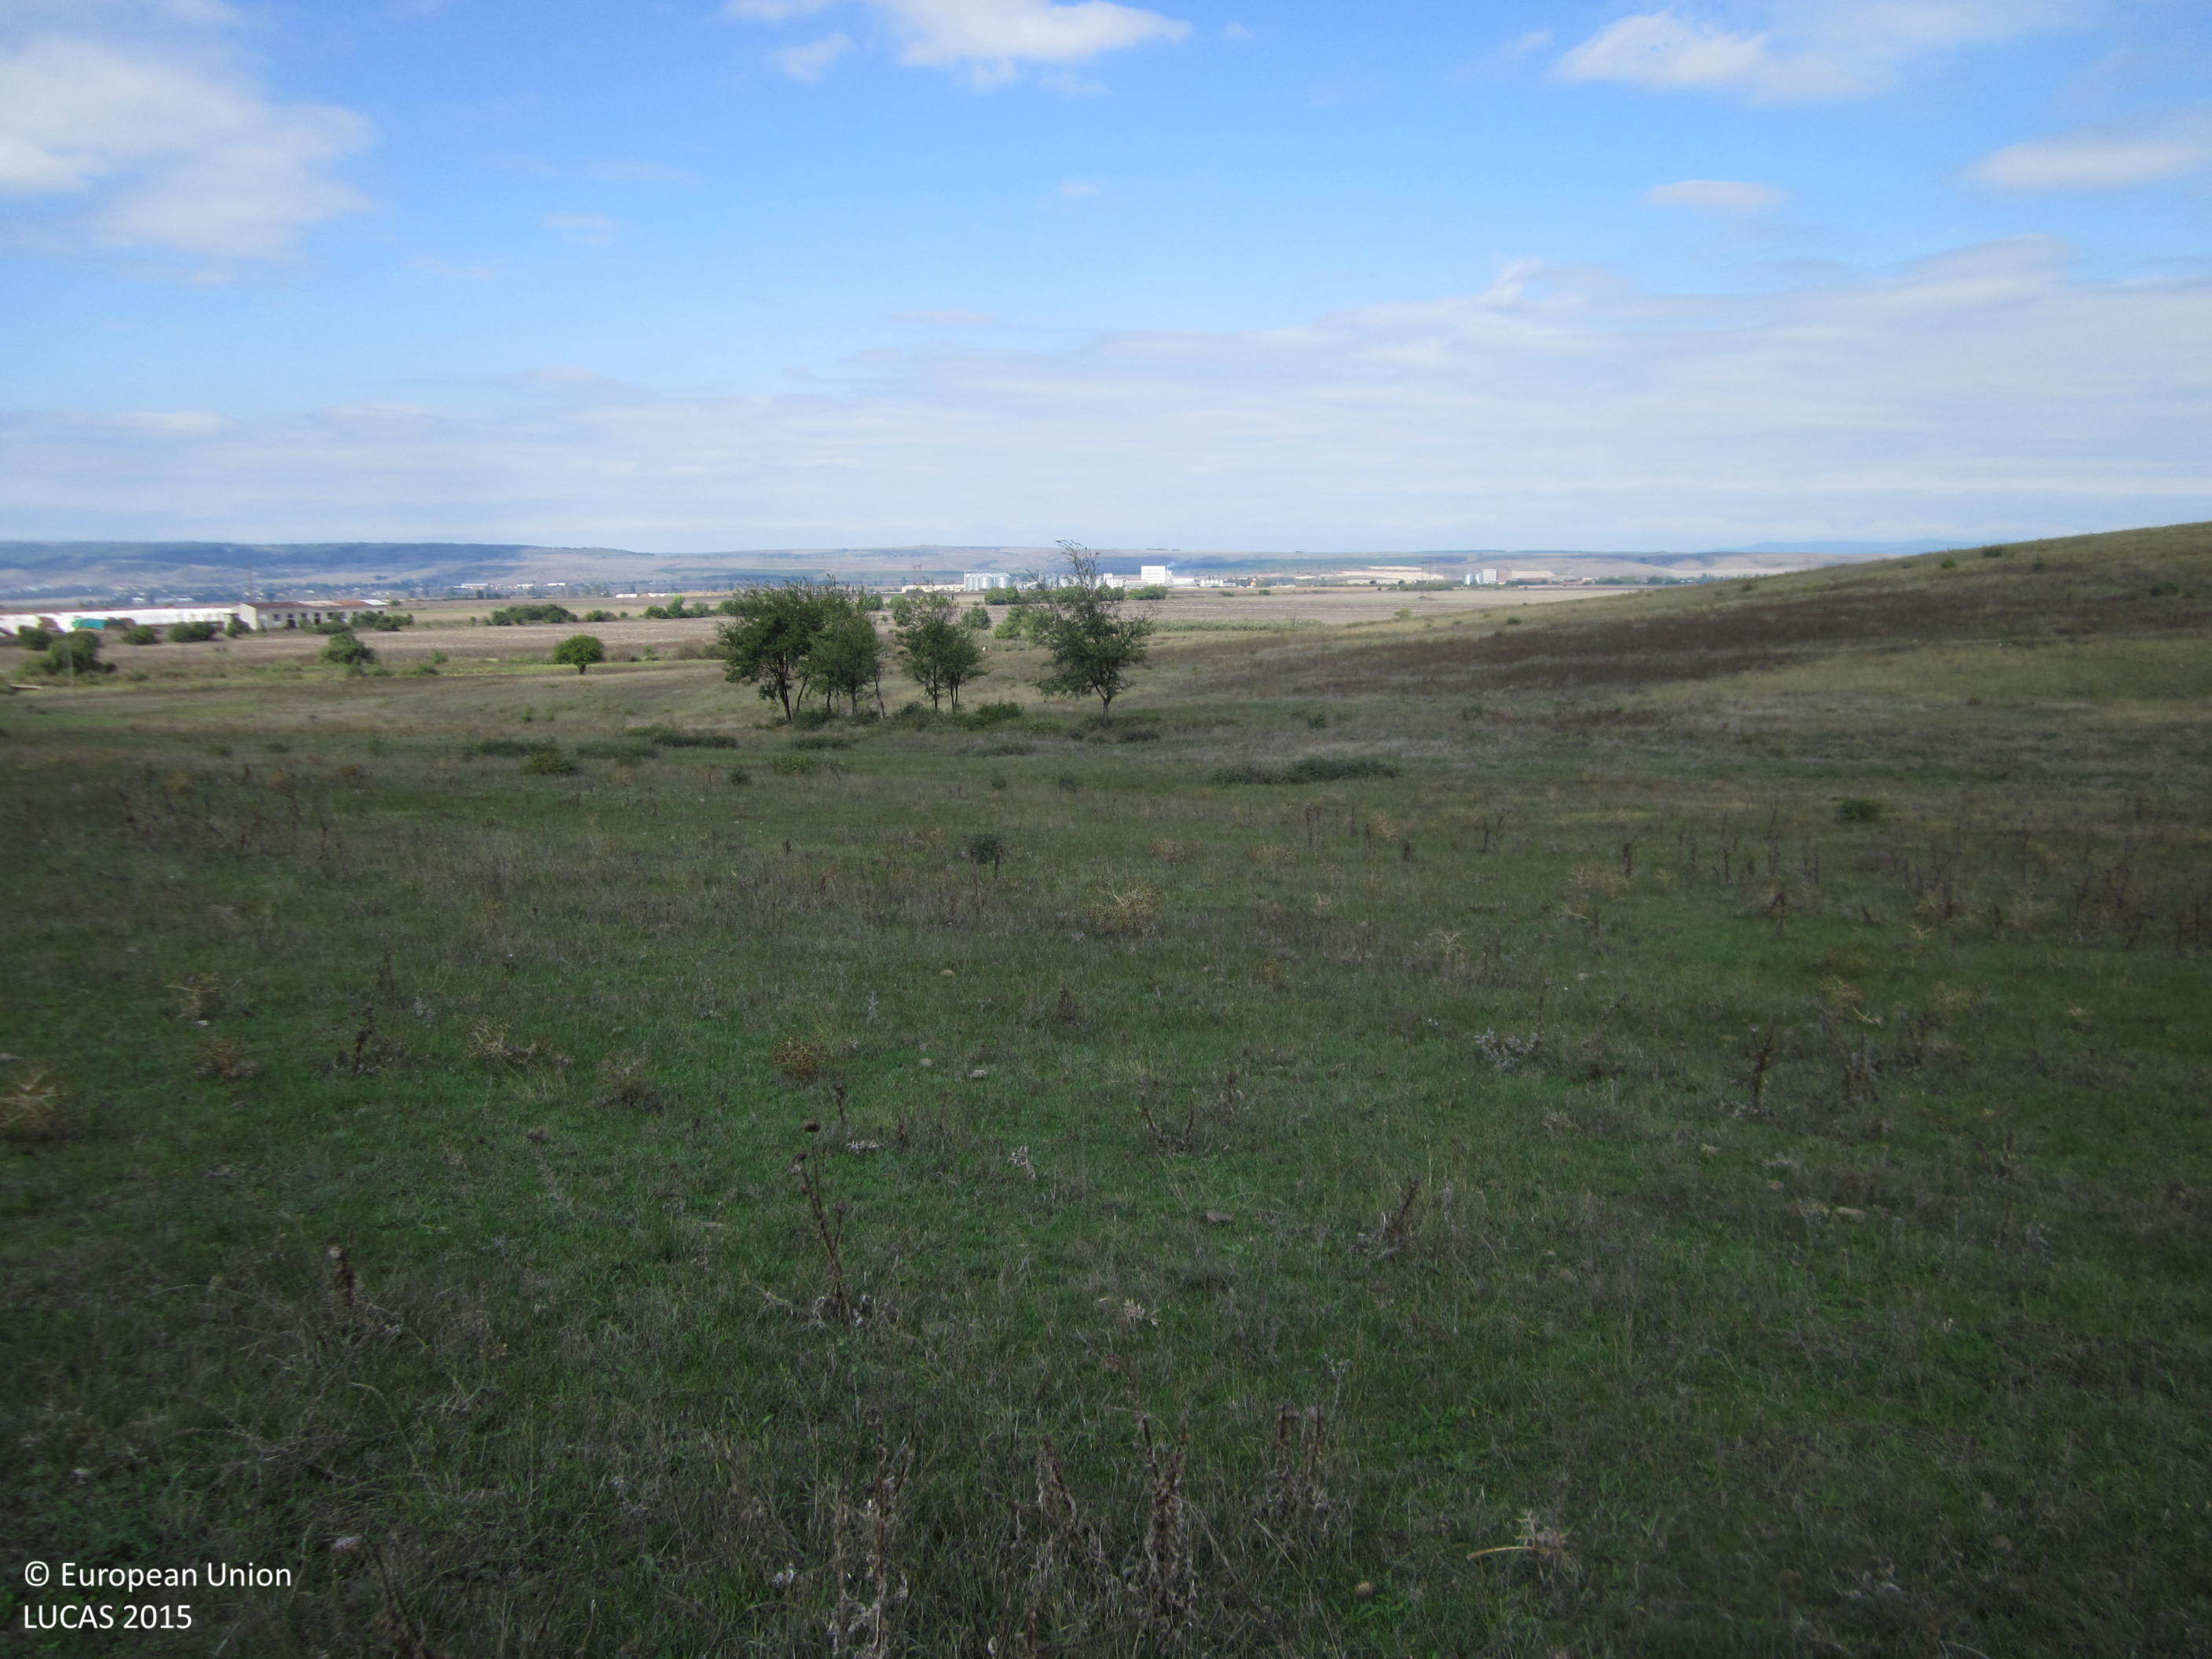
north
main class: Grassland
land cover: Grassland without tree/shrub cover
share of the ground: > 75 %
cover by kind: herbaceous plants 100 %
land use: Agriculture (excluding fallow land and kitchen gardens)
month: October
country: BG
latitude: 42.5951
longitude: 26.8345
